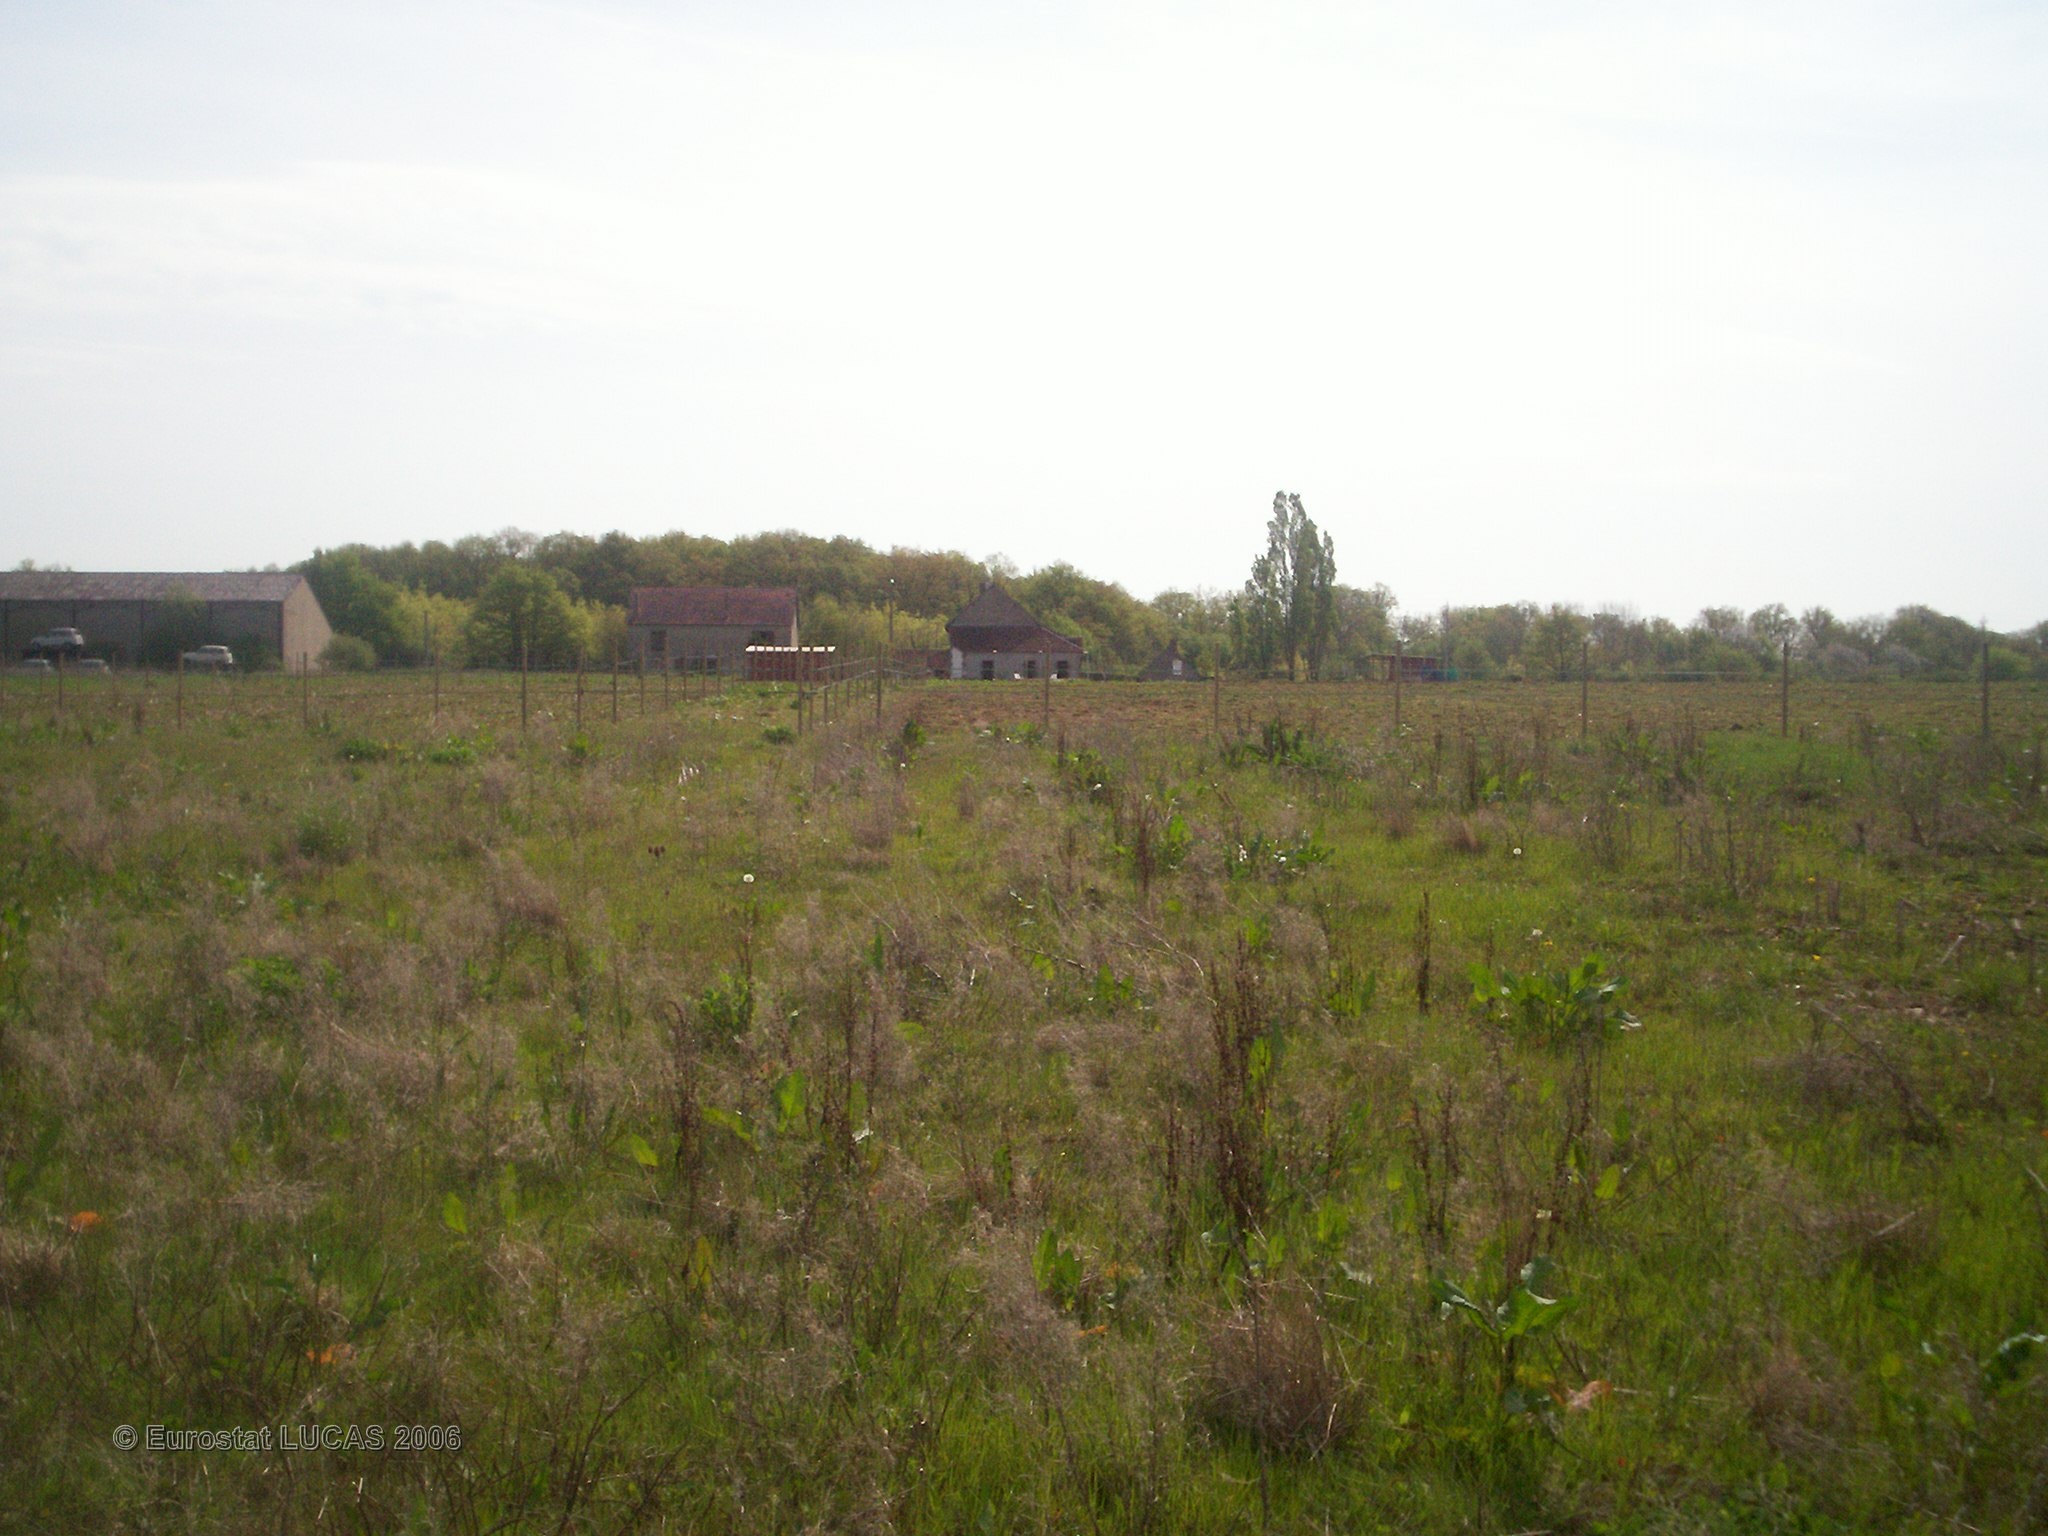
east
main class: Grassland
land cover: Grassland without tree/shrub cover
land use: Fallow land
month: May
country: FR
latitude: 47.6025
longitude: 2.9843
